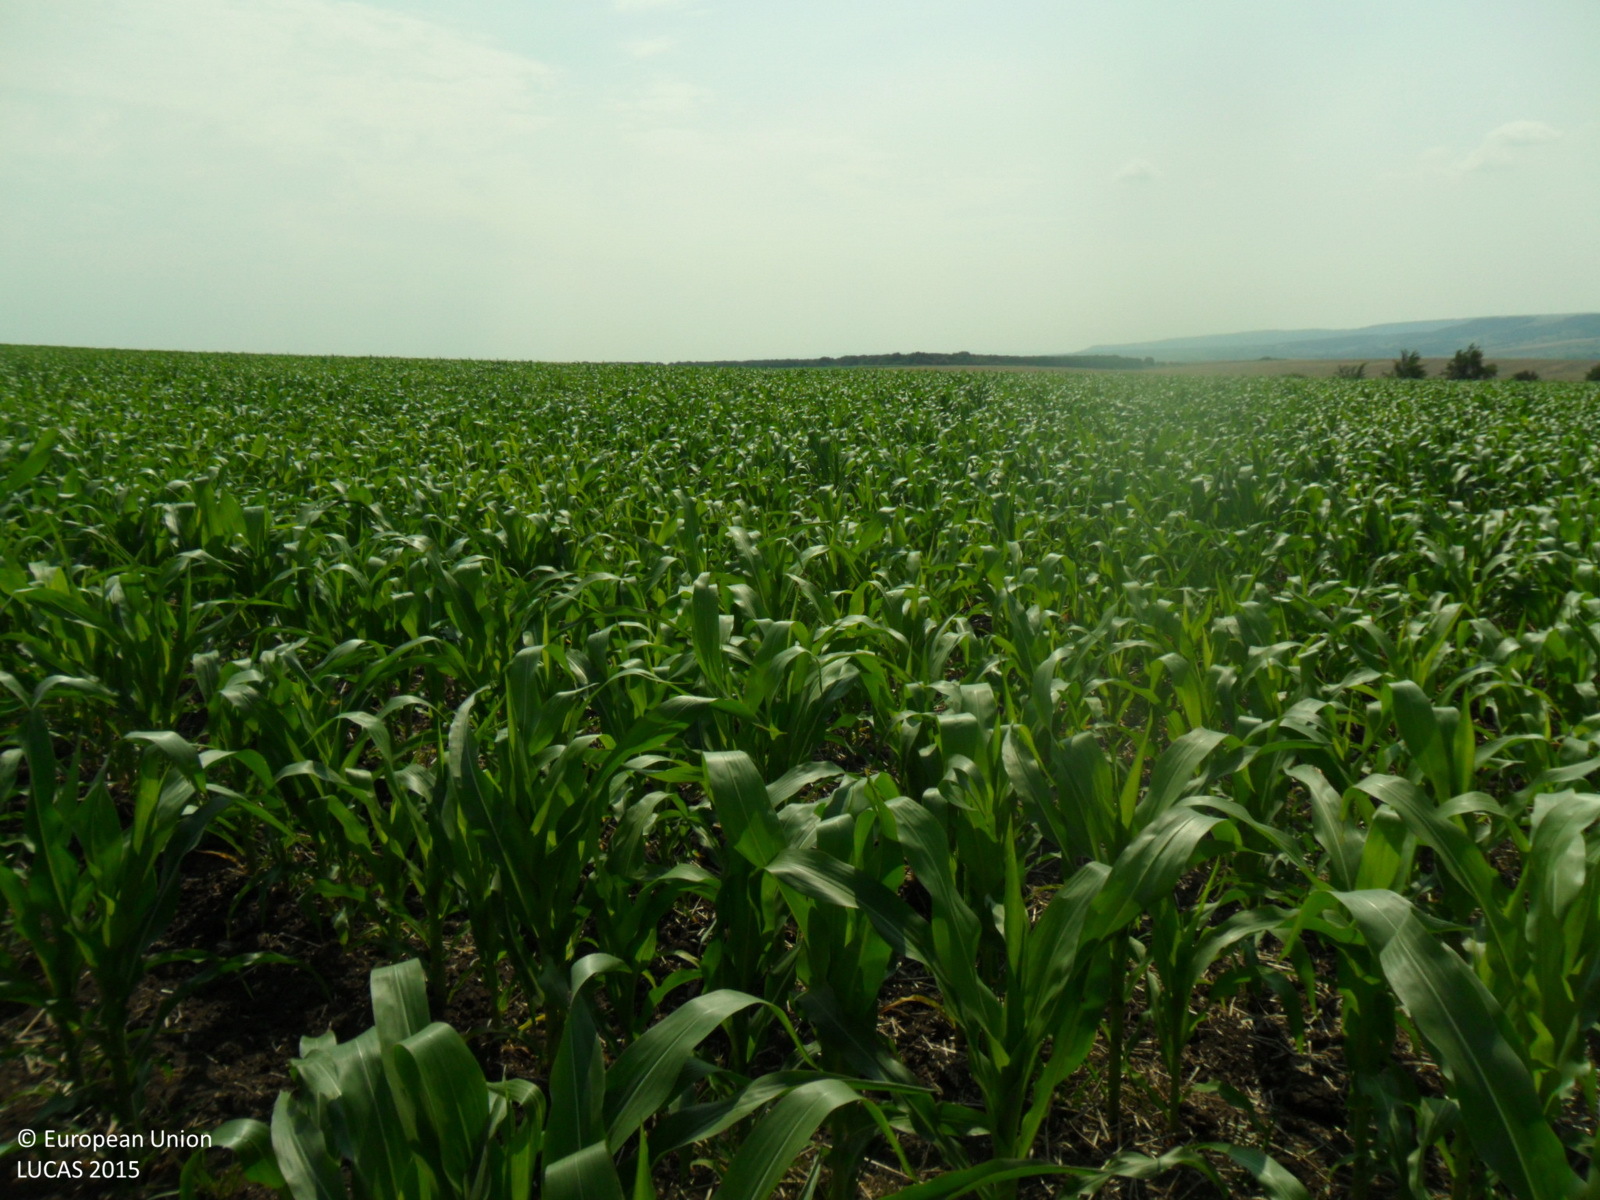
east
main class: Cropland
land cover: Maize
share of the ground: > 75 %
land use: Agriculture (excluding fallow land and kitchen gardens)
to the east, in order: Maize
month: June
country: BG
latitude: 43.3586
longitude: 26.7796
